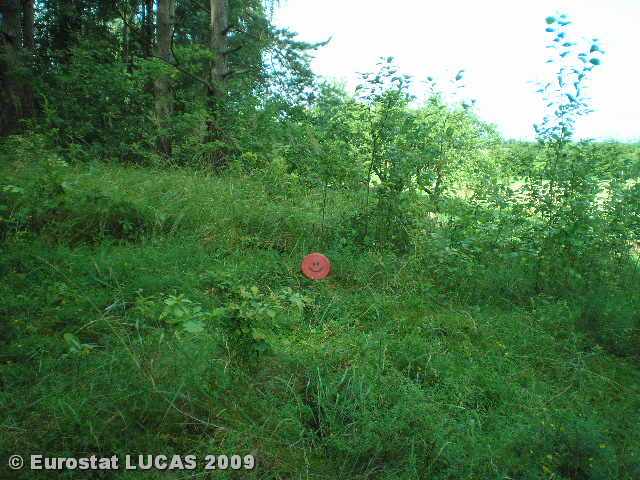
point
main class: Woodland
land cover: Mixed woodland
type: hemiboreal forest and nemoral coniferous forest and mixed broadleaved-coniferous forest
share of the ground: > 75 %
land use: Forestry
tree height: > 5 m
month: July
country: LT
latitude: 54.8674
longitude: 25.3777
